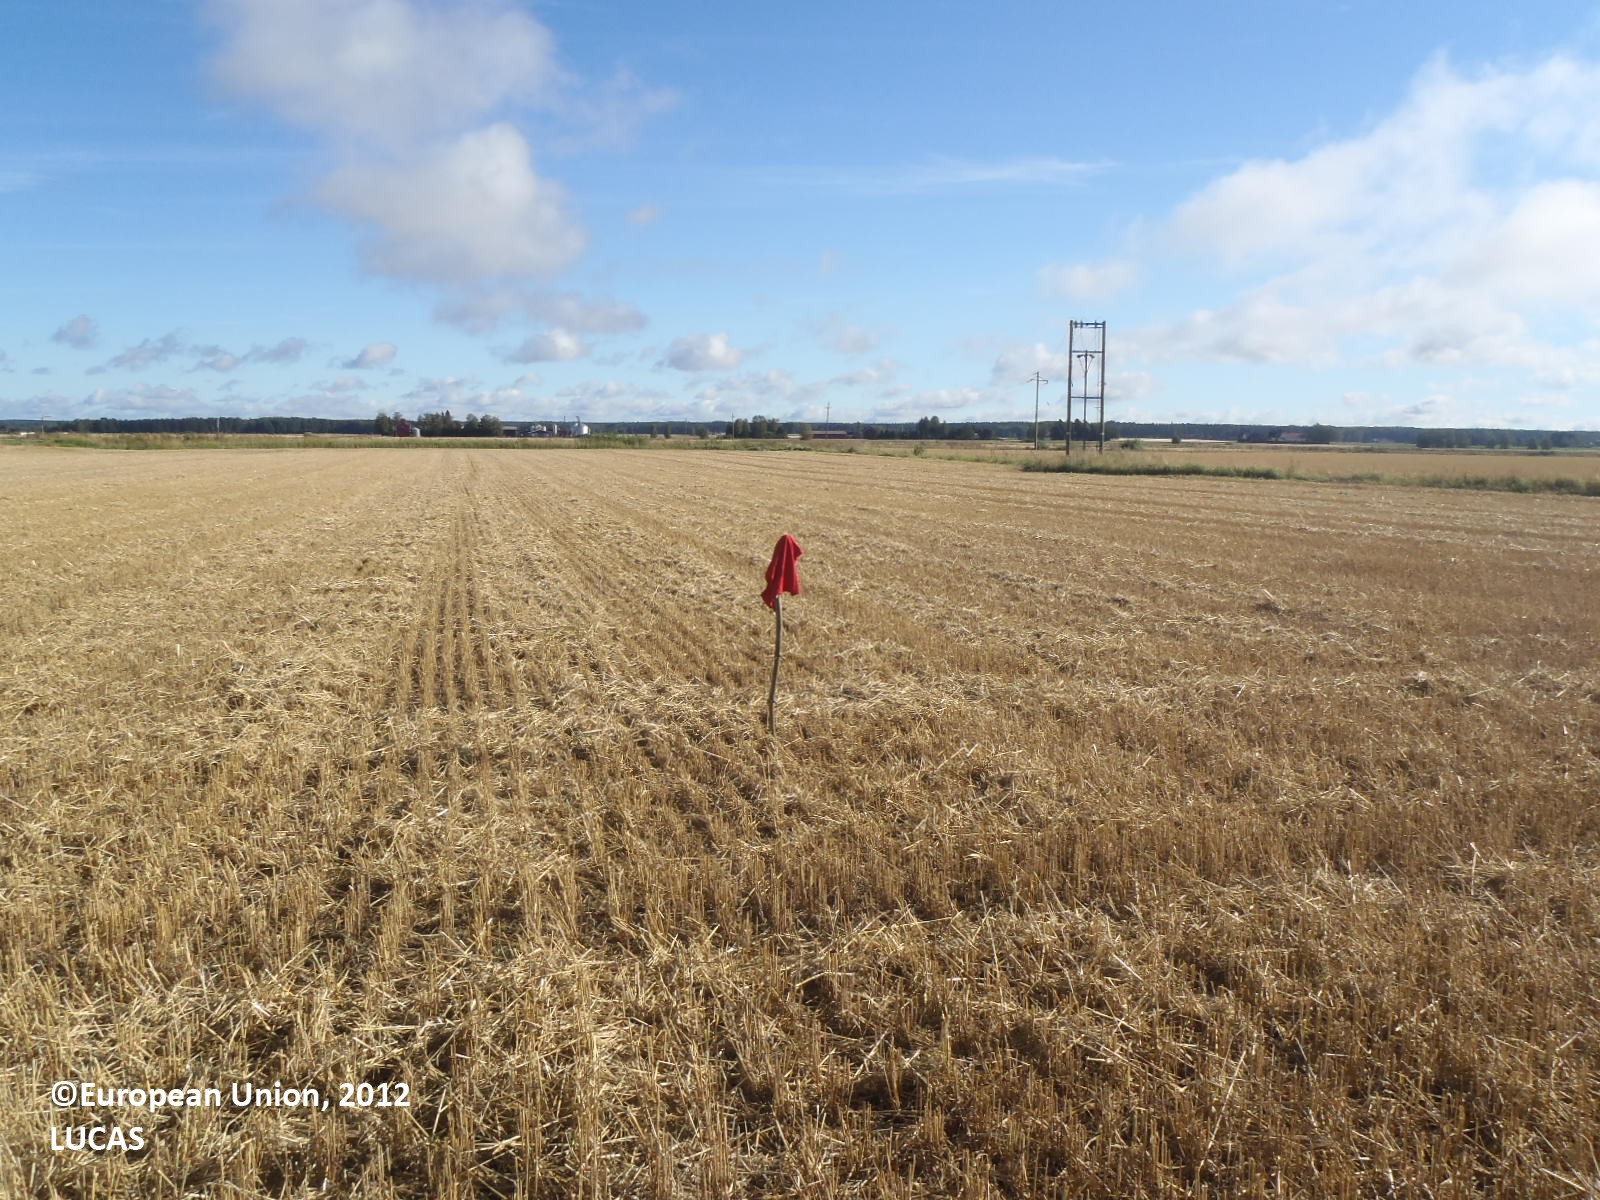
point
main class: Cropland
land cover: Barley
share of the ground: > 75 %
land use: Agriculture (excluding fallow land and kitchen gardens)
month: September
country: FI
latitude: 61.0600
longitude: 22.3469
